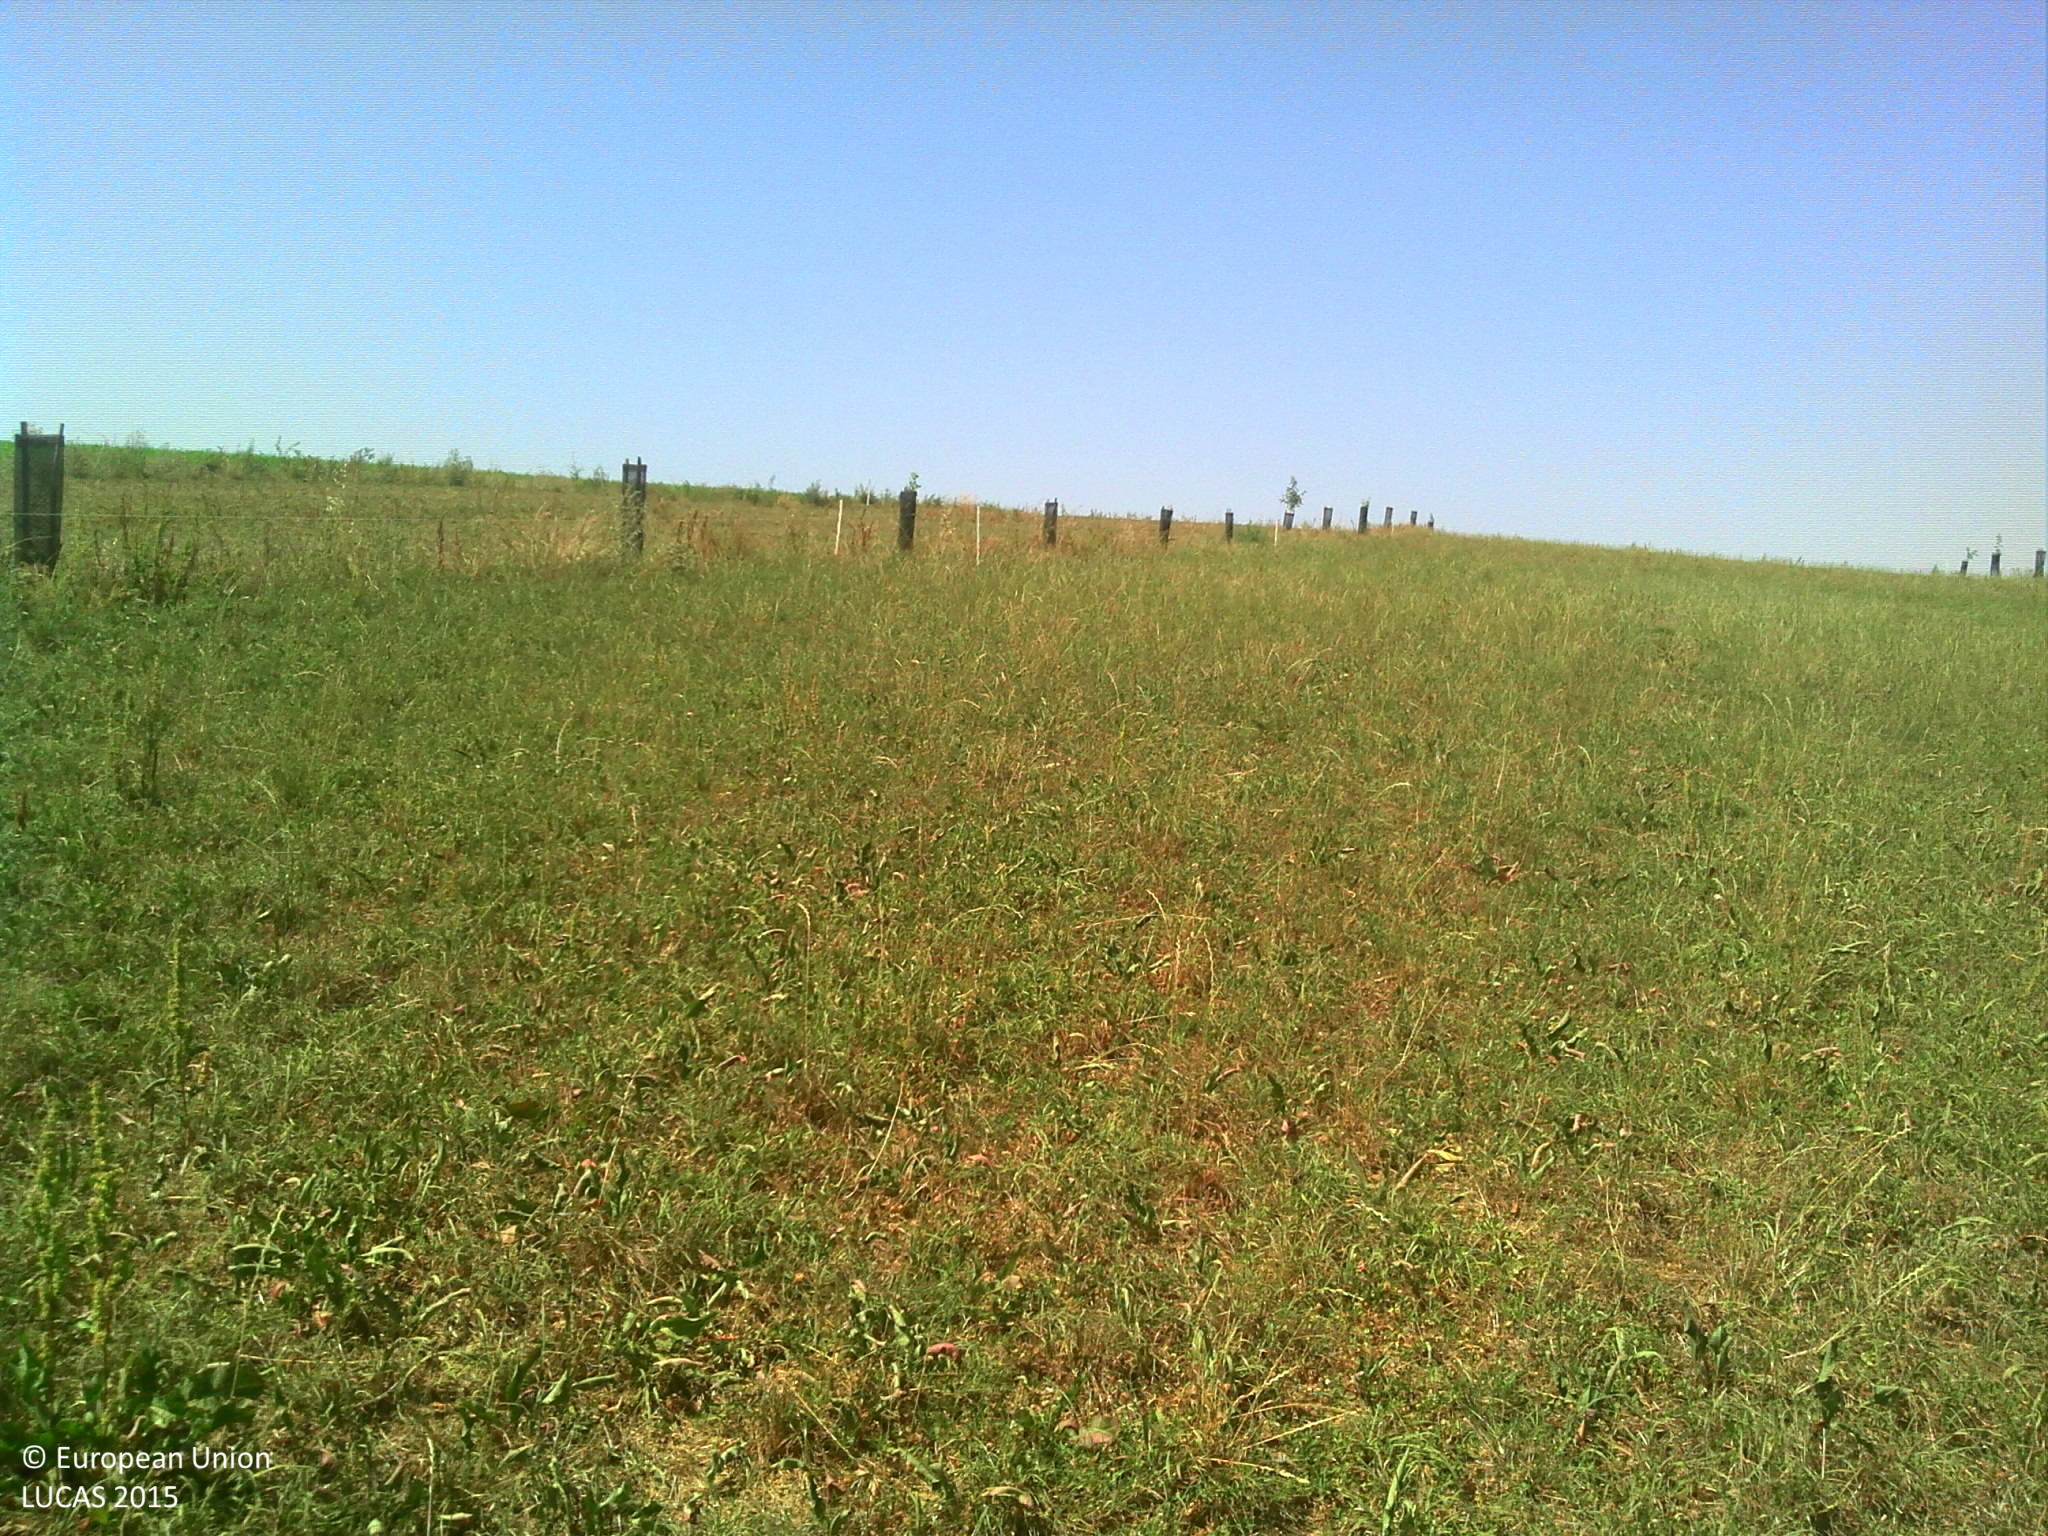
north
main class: Grassland
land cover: Grassland without tree/shrub cover
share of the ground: > 75 %
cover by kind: herbaceous plants 100 %
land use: Agriculture (excluding fallow land and kitchen gardens)
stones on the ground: 10 - 25 %
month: July
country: FR
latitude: 44.0115
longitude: 0.9798
